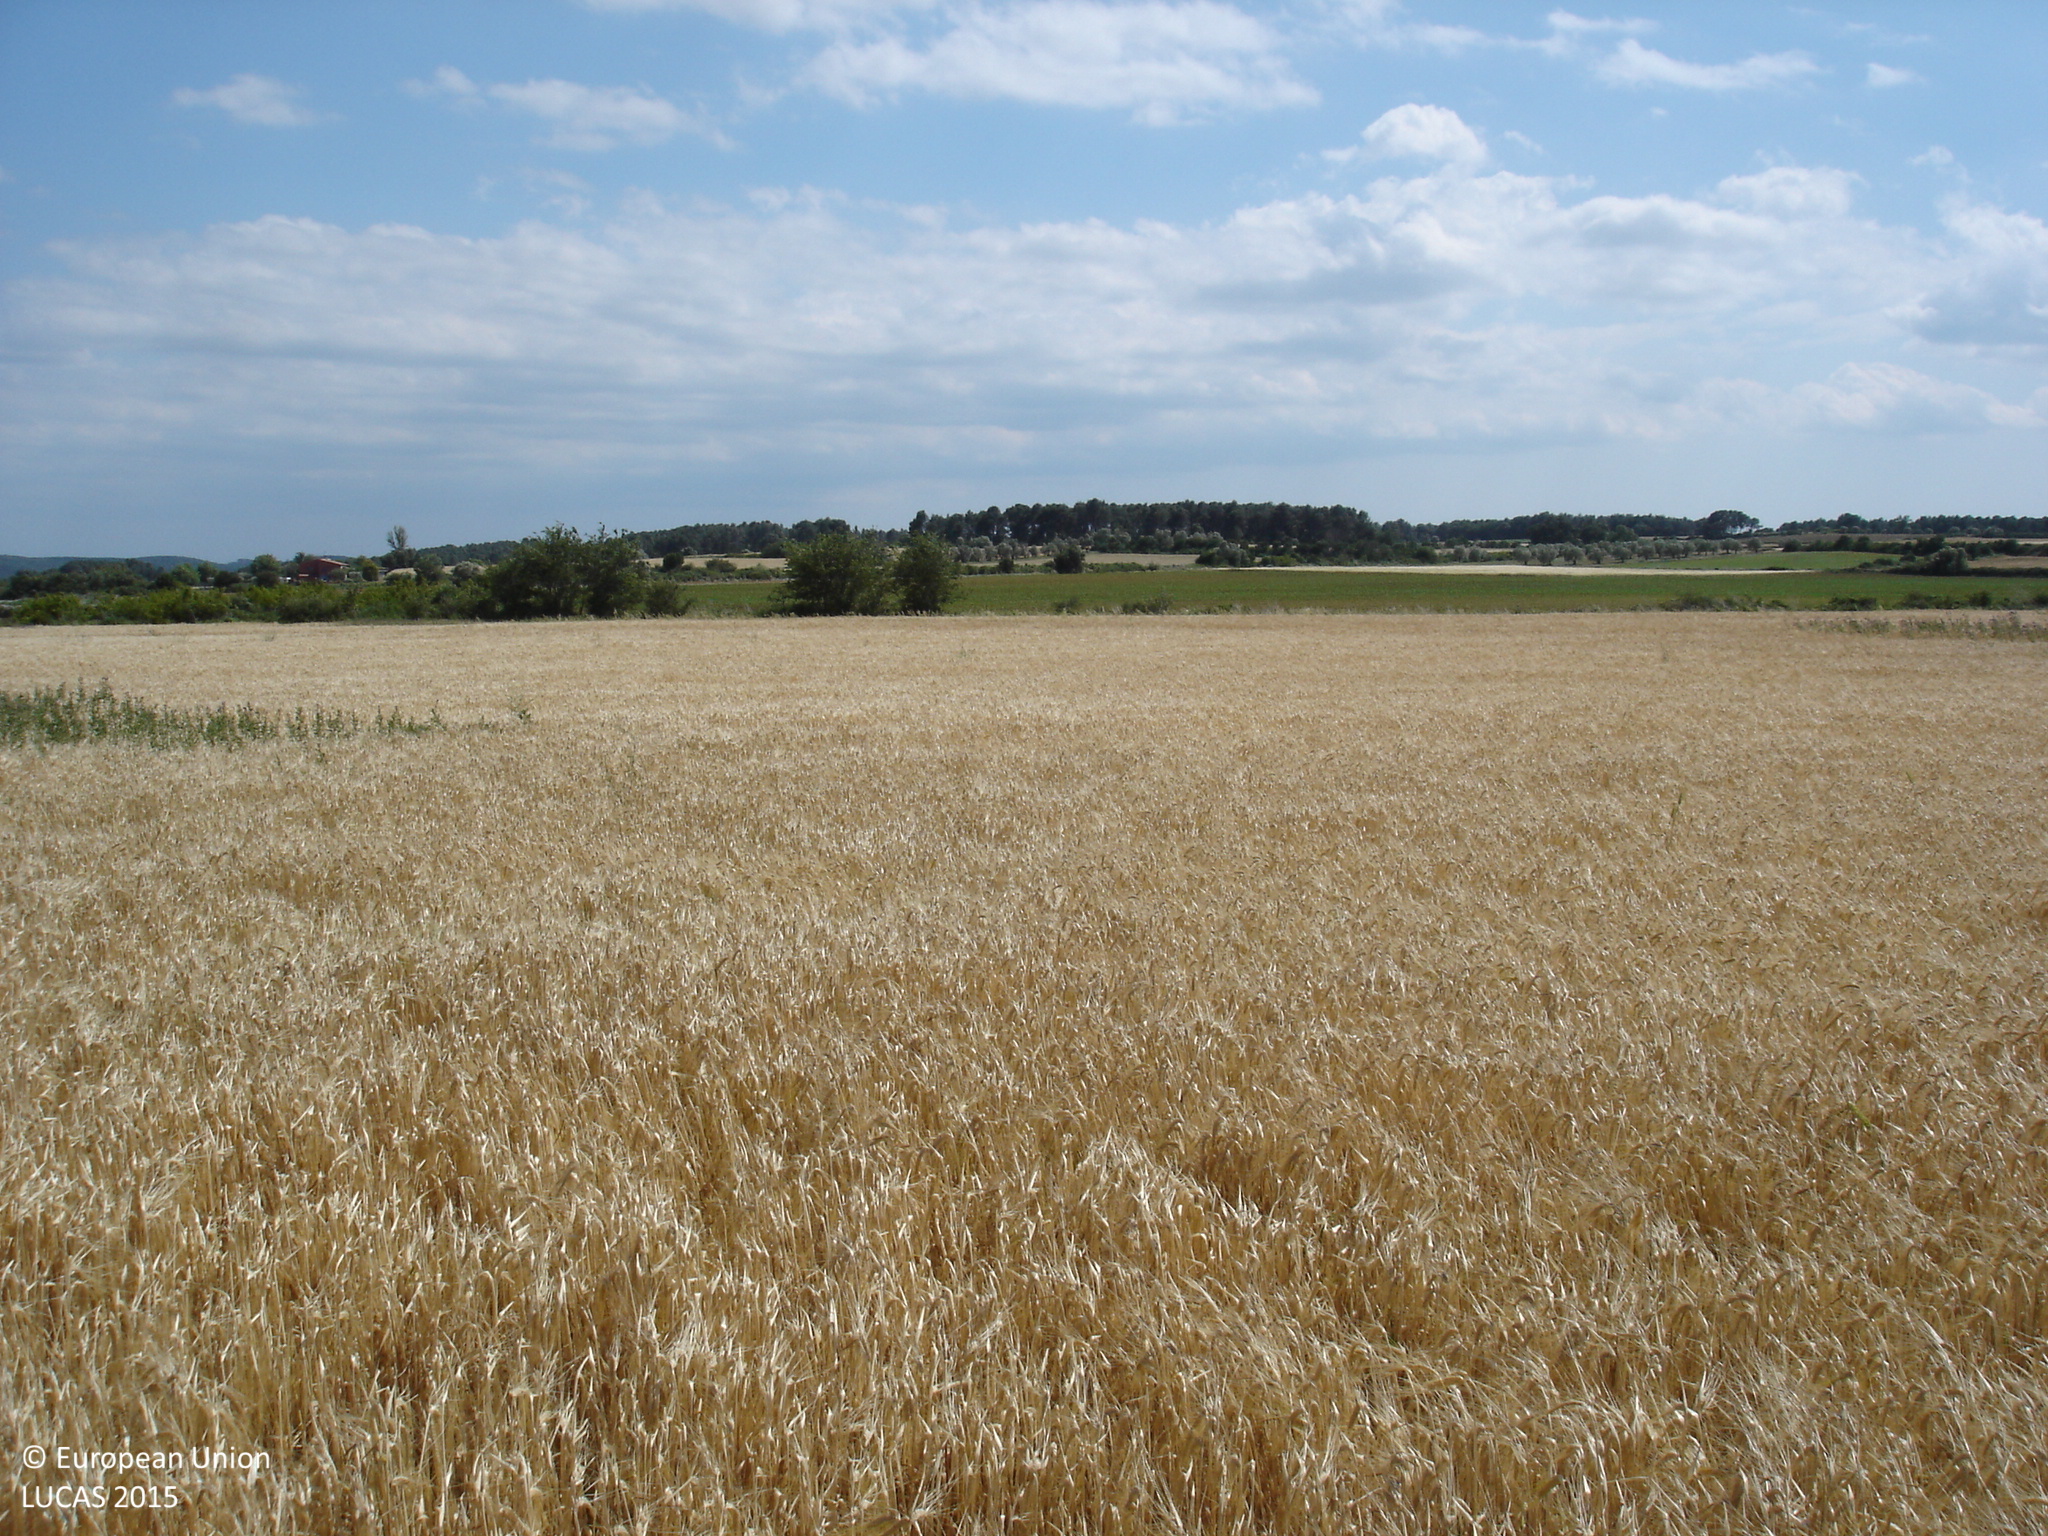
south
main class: Cropland
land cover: Barley
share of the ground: > 75 %
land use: Agriculture (excluding fallow land and kitchen gardens)
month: May
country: ES
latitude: 42.1927
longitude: 2.9791
